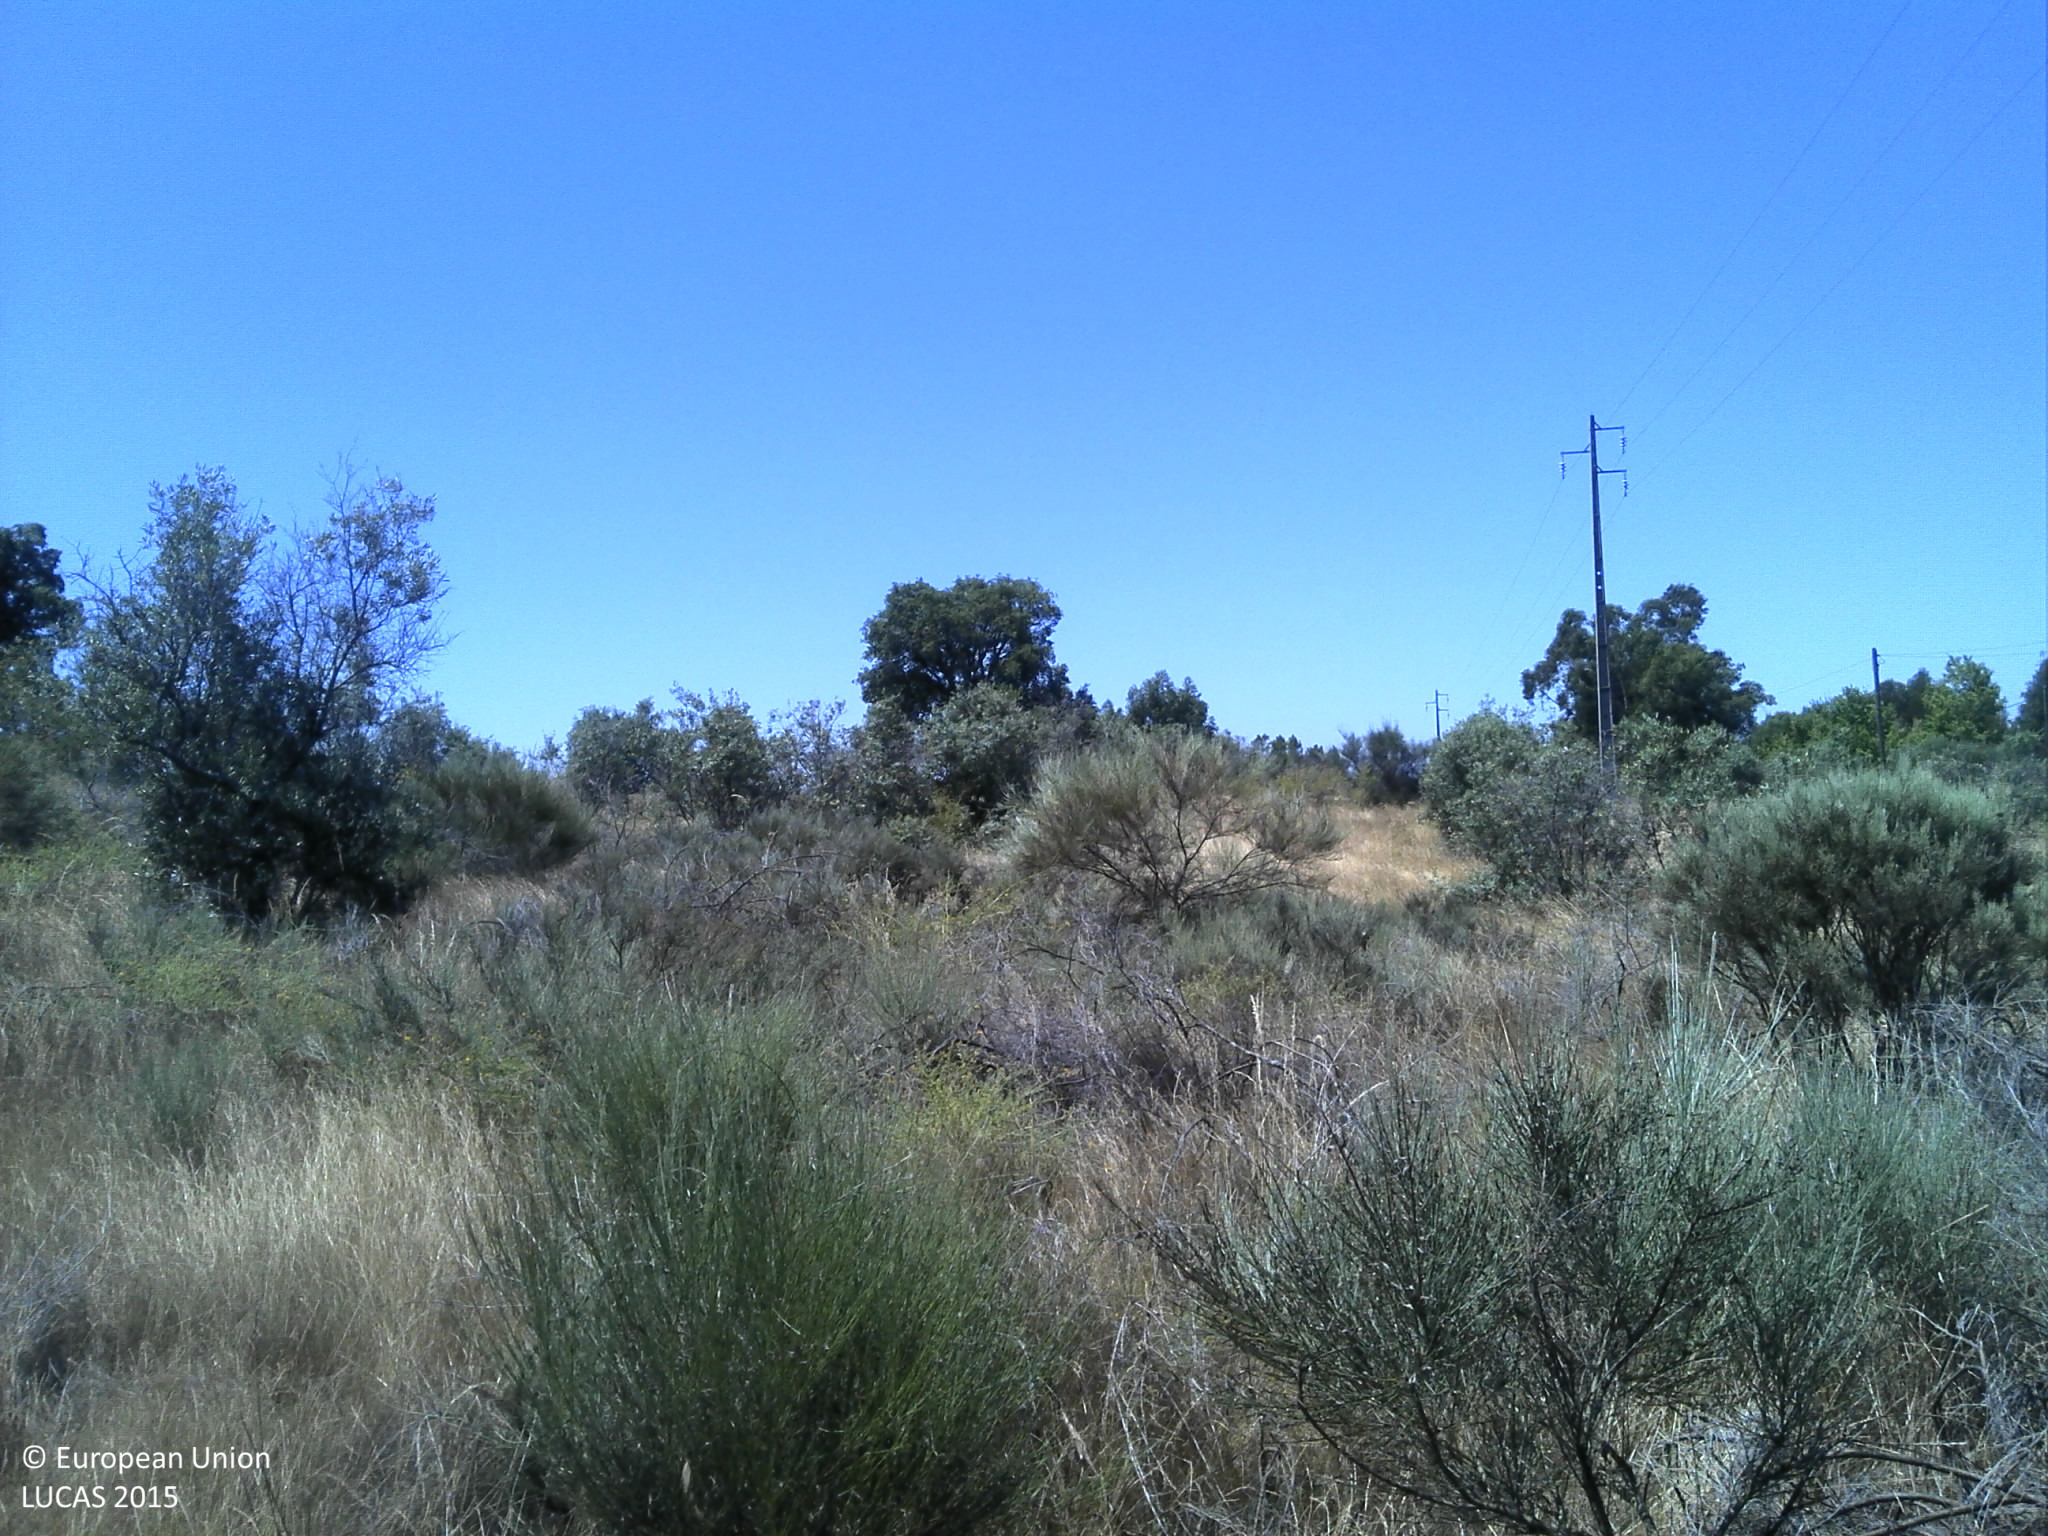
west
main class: Shrubland
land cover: Shrubland with sparse tree cover
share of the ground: 25 - 50 %
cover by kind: shrubs 40 %, herbaceous plants 40 %, unconsolidated bare surface 10 %, broadleaved forest trees 5 %
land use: Abandoned areas
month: June
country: PT
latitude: 40.0035
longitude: -7.3294
